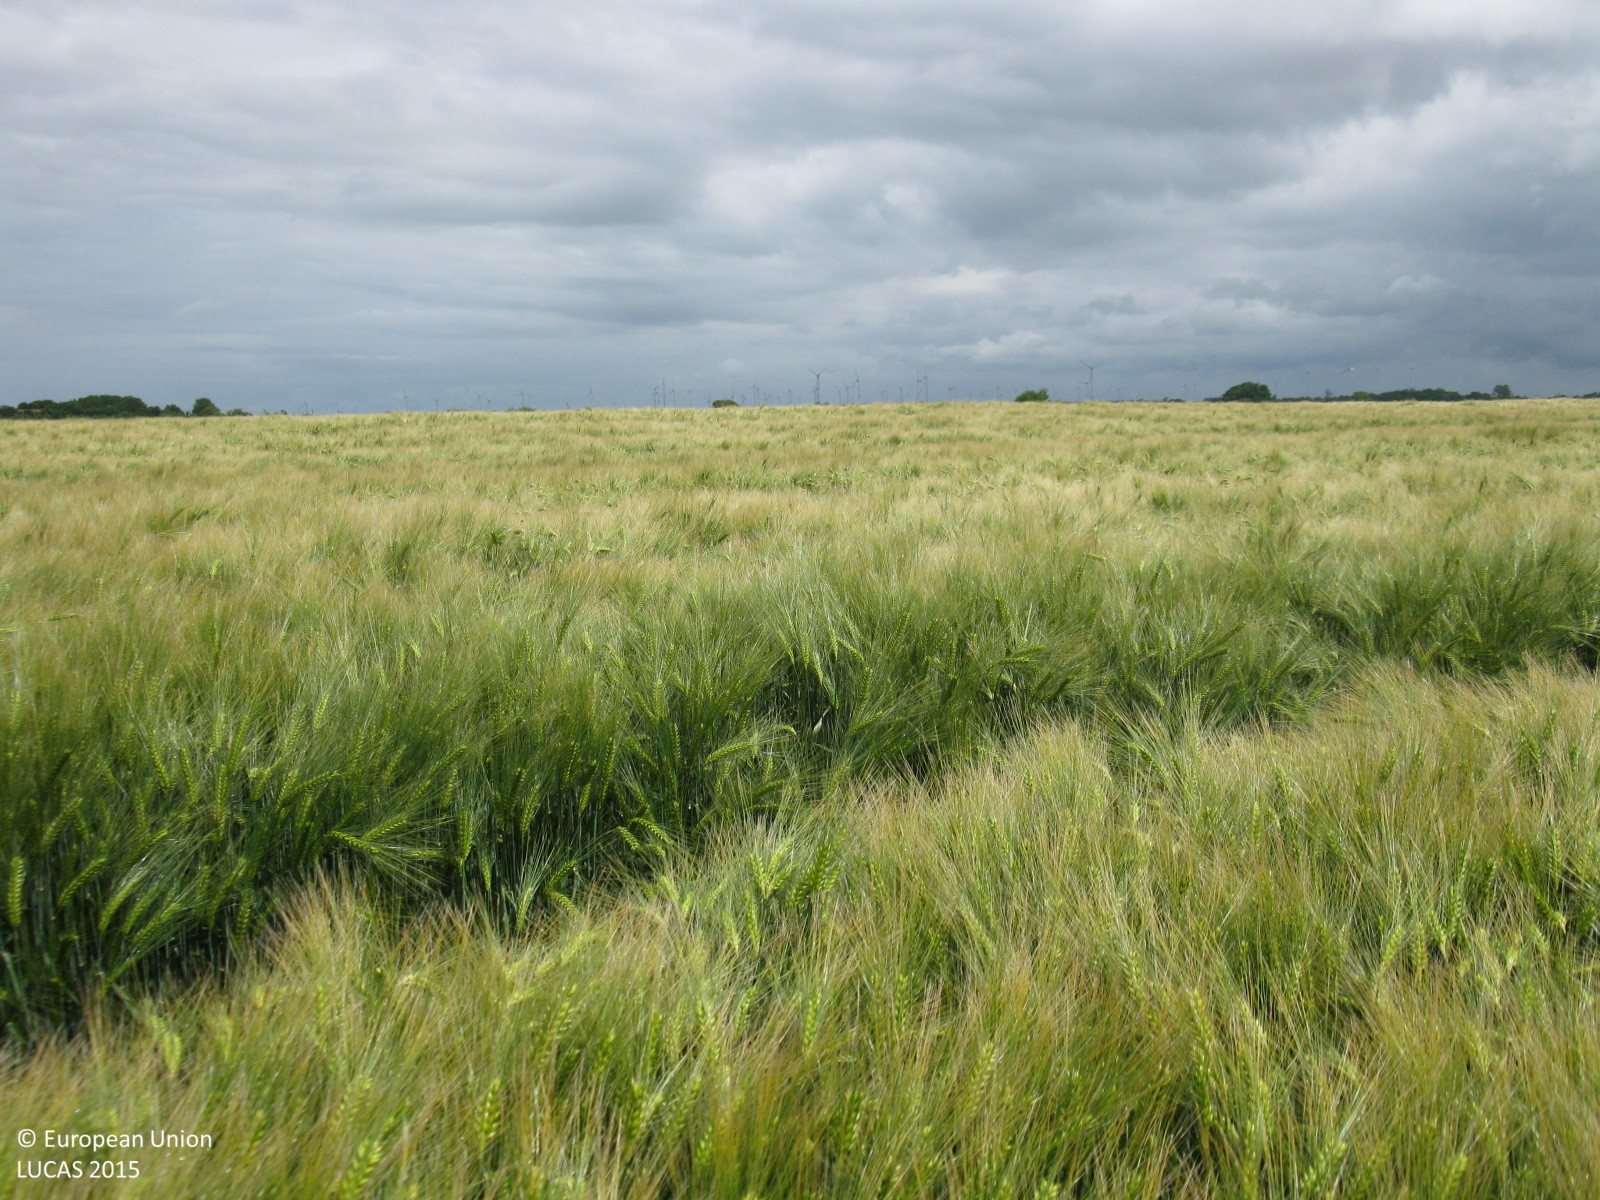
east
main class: Cropland
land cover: Common wheat
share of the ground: > 75 %
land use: Agriculture (excluding fallow land and kitchen gardens)
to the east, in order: Common wheat; Grass margins; Ditches and canals; Grass margins; Barley
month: June
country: DE
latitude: 53.6242
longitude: 7.3245
